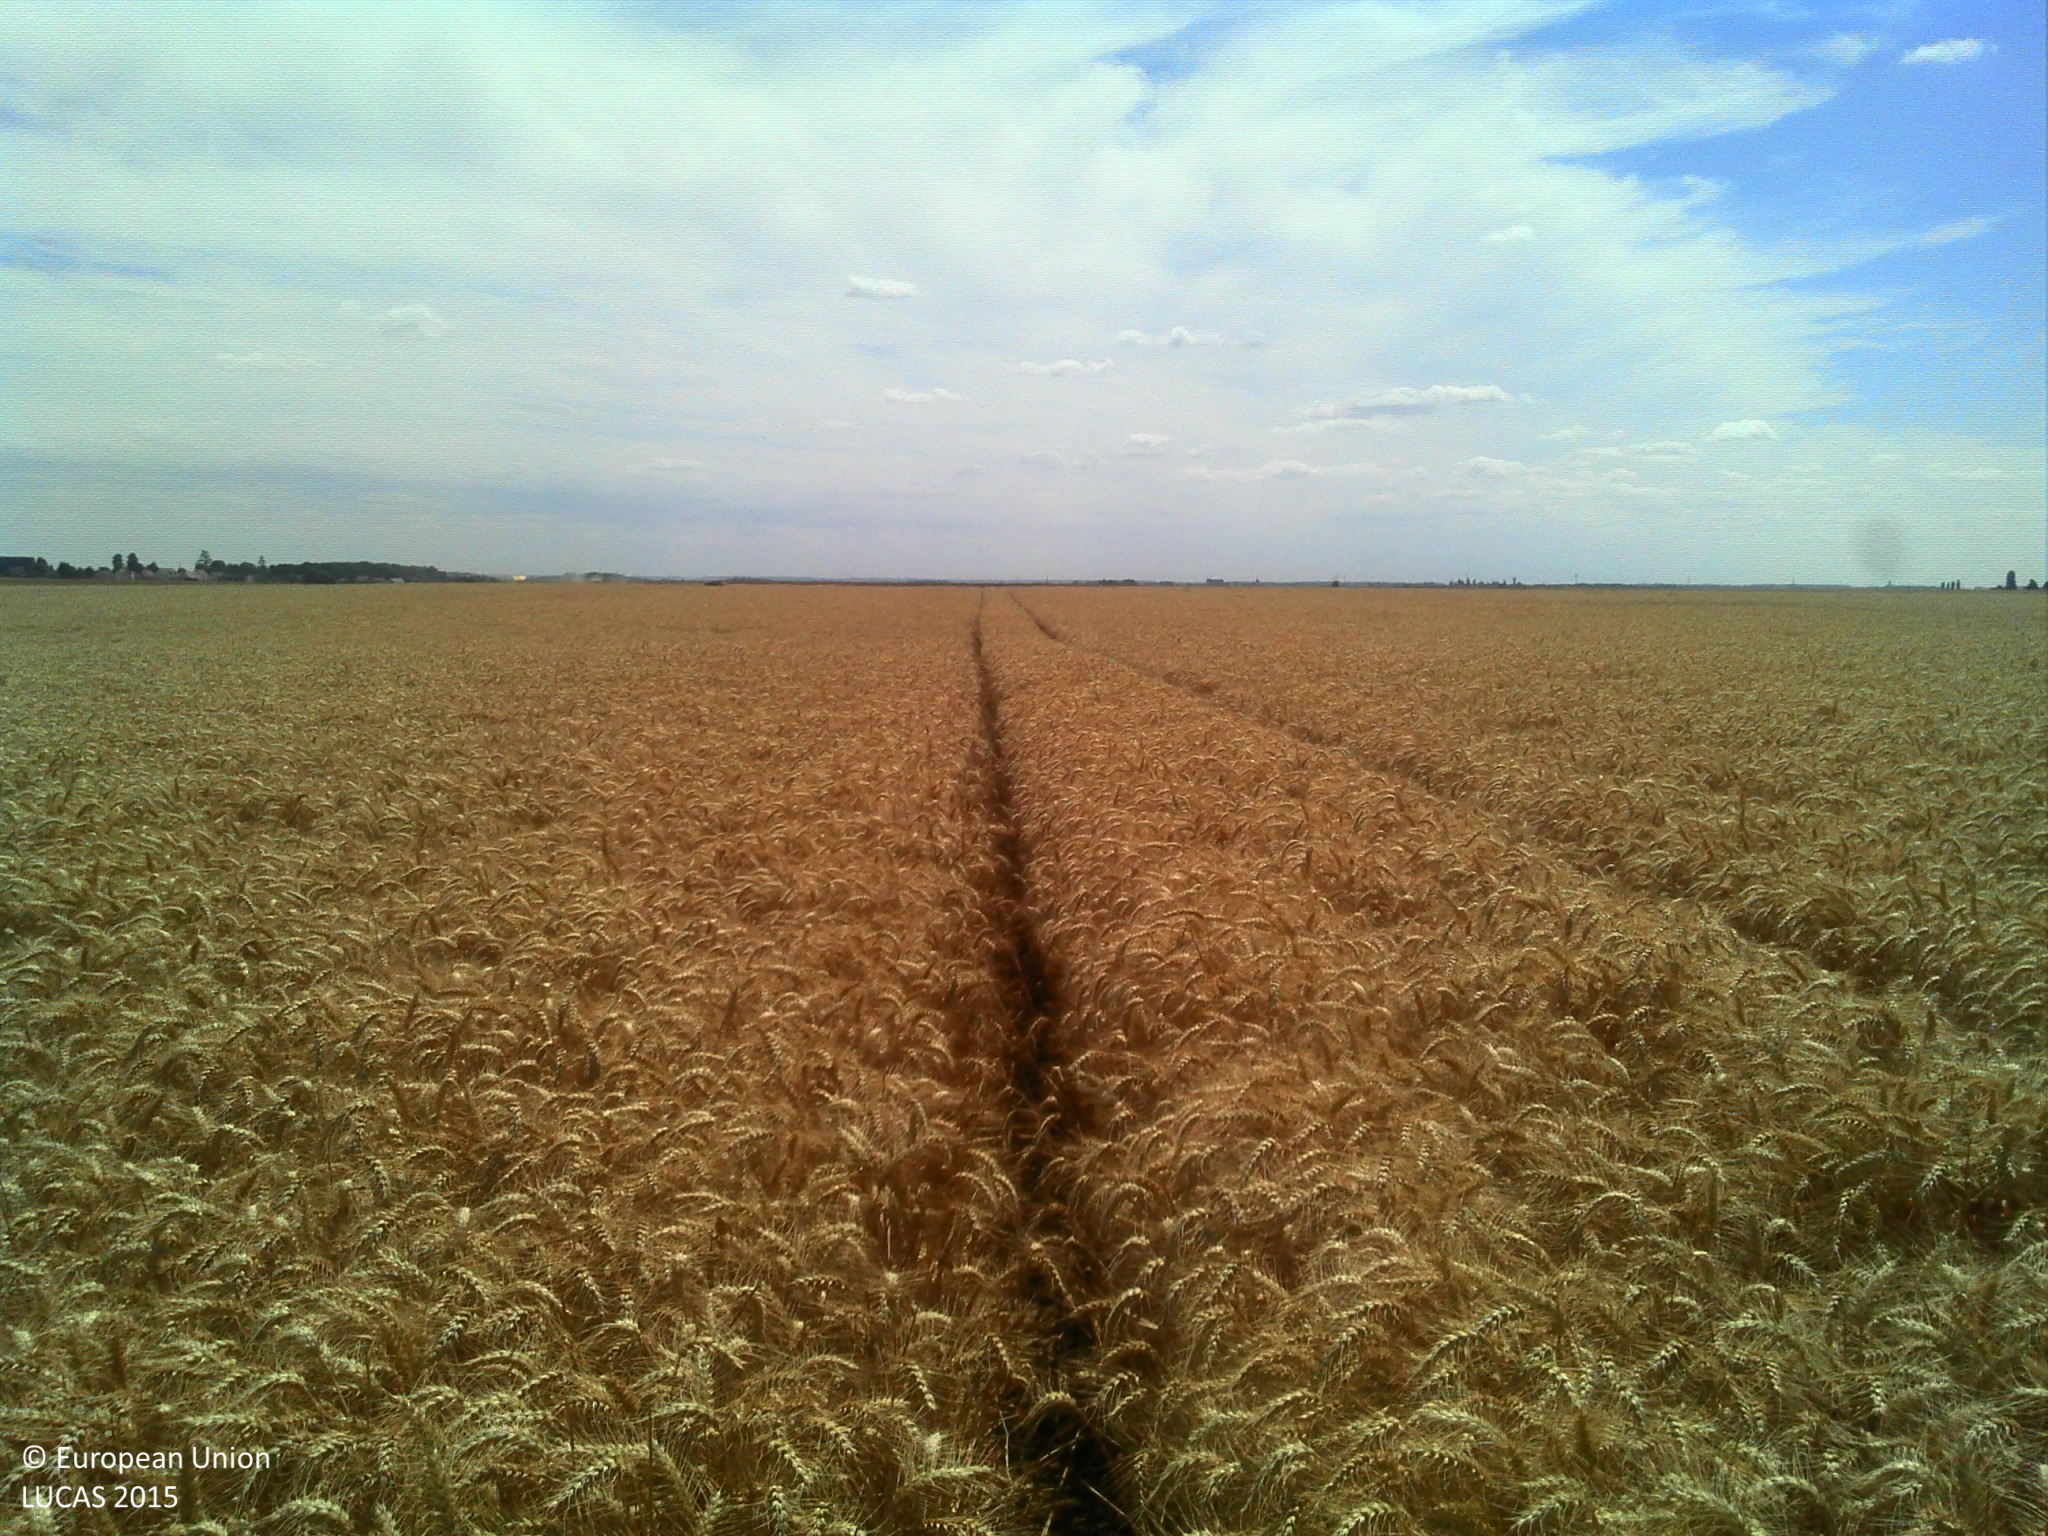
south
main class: Cropland
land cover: Common wheat
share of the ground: > 75 %
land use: Agriculture (excluding fallow land and kitchen gardens)
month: July
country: FR
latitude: 48.3636
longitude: 1.2488
